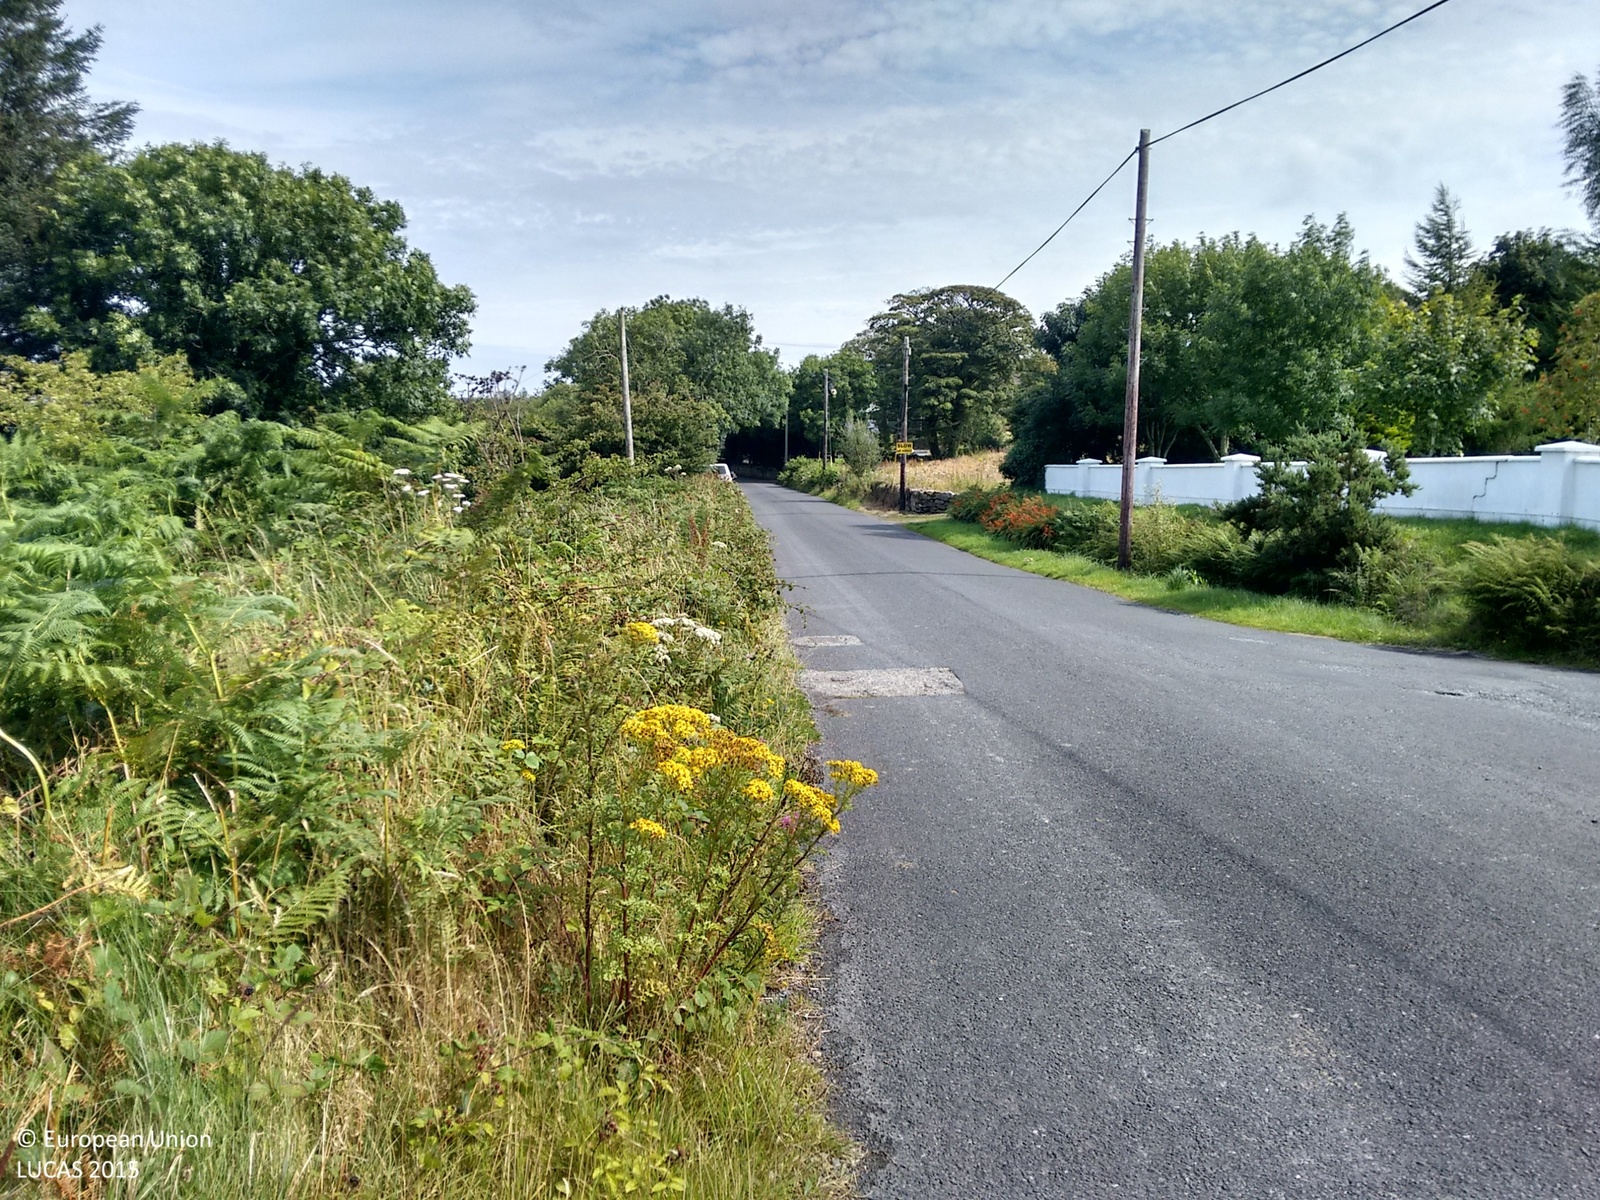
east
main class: Shrubland
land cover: Shrubland with sparse tree cover
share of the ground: > 75 %
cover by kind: shrubs 95 %, broadleaved forest trees 5 %
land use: Residential
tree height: > 5 m
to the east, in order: Shrubland with sparse tree cover; Artificial constructions in urban areas; Abandoned hedges; Fences; Grassland without tree/shrub cover; Grass margins; Electric lines; Shruby margins; Artificial constructions in urban areas
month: August
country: IE
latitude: 52.3211
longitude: -6.5766
